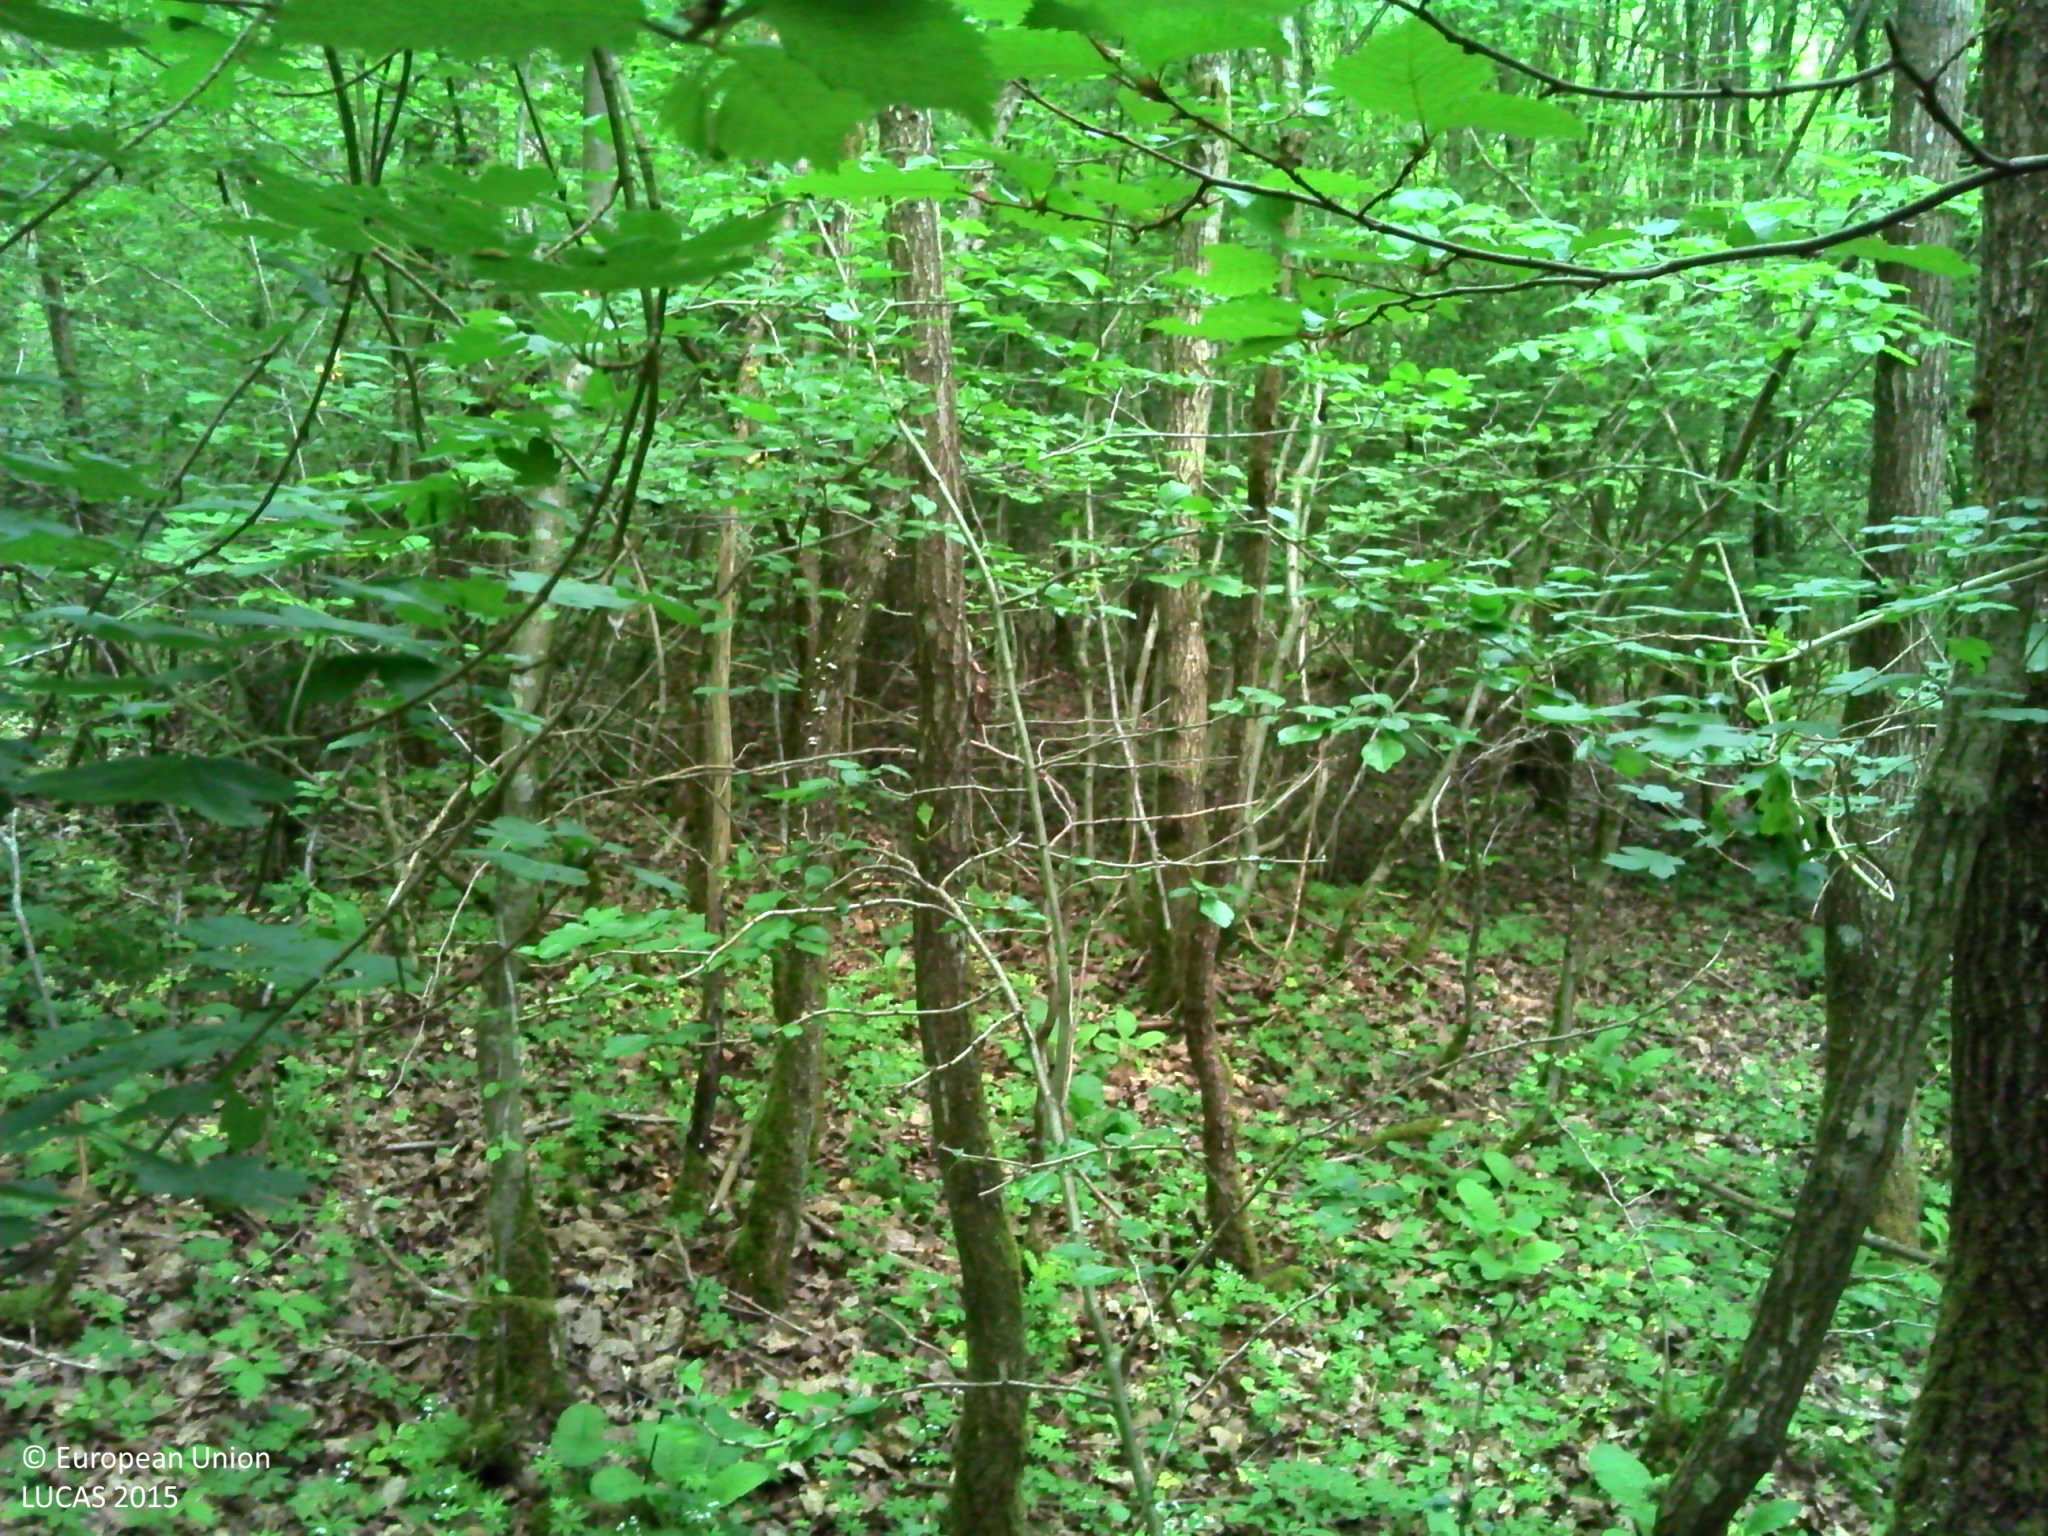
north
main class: Woodland
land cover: Broadleaved woodland
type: mesophytic deciduous forest
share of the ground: > 75 %
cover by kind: broadleaved forest trees 90 %, herbaceous plants 5 %, lichens and mosses 5 %
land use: Forestry
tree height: > 5 m
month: May
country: LU
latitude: 49.6769
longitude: 6.3827
